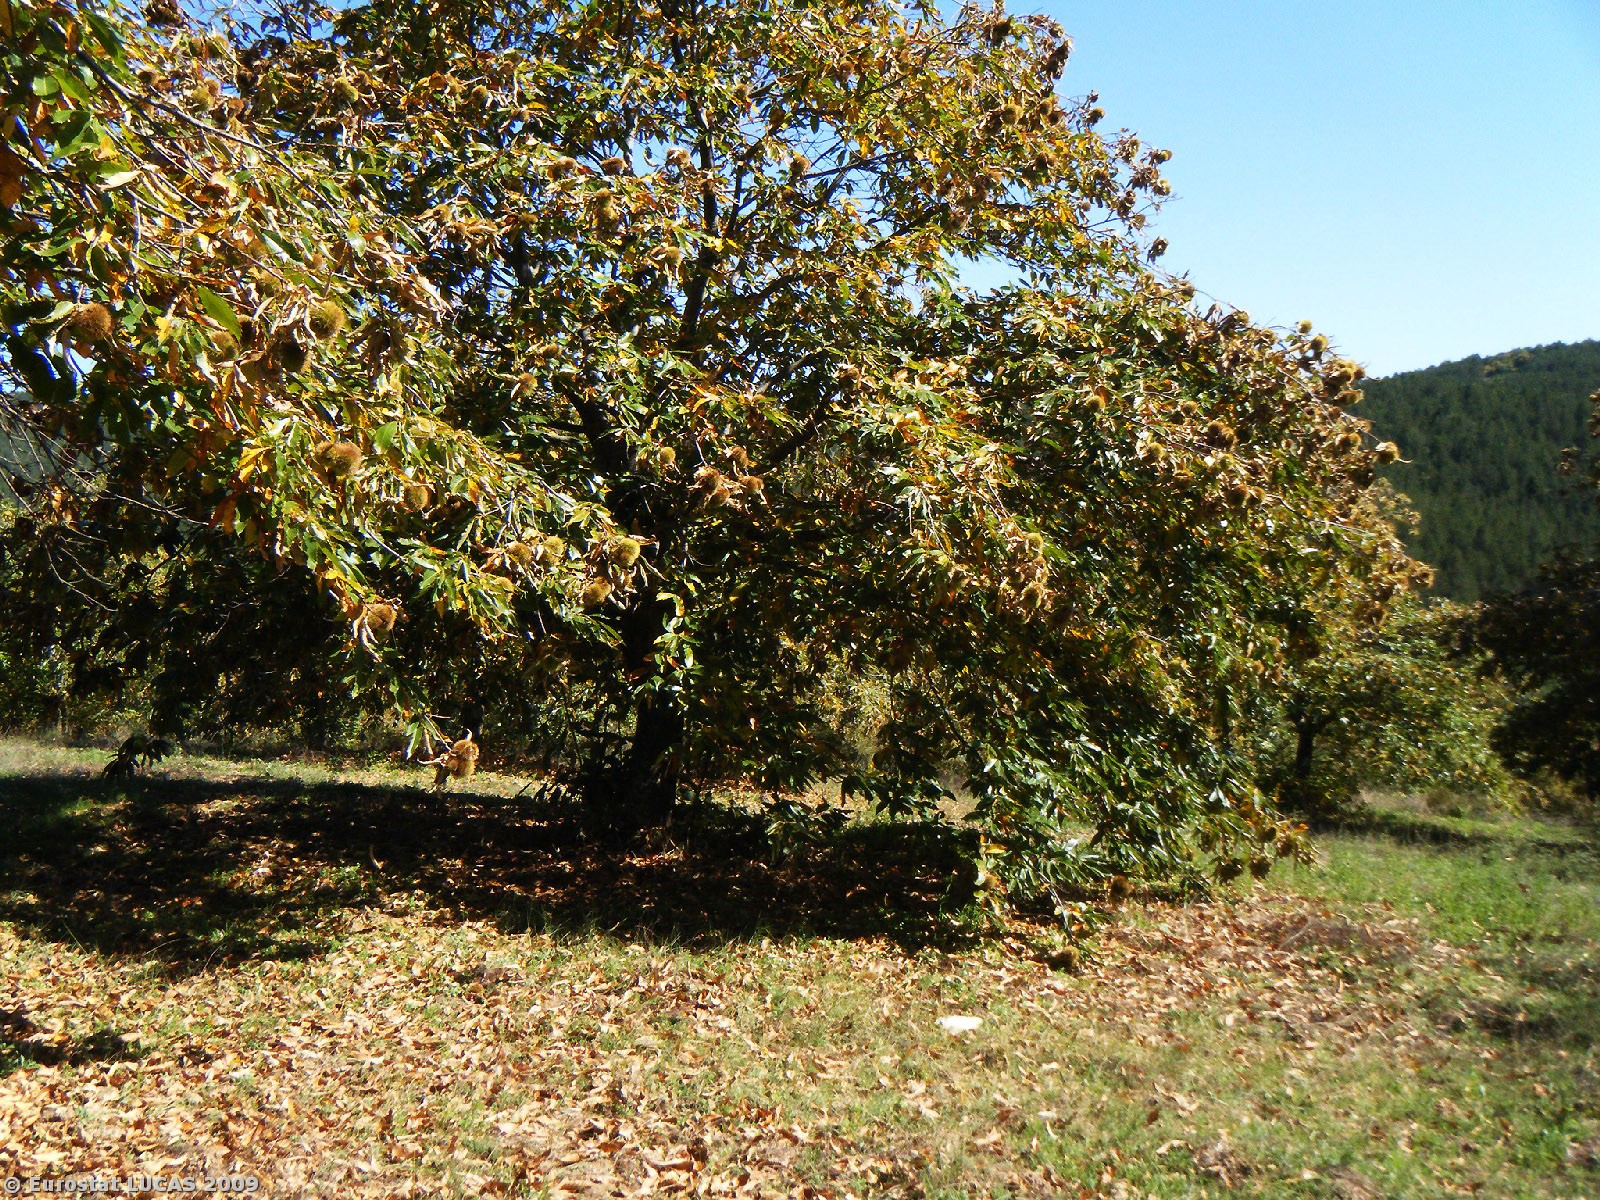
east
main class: Cropland
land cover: Nuts trees
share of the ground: 25 - 50 %
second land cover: Grassland with sparse tree/shrub cover
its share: > 75 %
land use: Agriculture (excluding fallow land and kitchen gardens)
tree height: > 5 m
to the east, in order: Nuts trees; Grassland with sparse tree/shrub cover; Abandoned hedges; Nuts trees; Grassland with sparse tree/shrub cover; Shrubland without tree cover; Nuts trees; Grassland with sparse tree/shrub cover; Shrubland without tree cover; Nuts trees; Grassland with sparse tree/shrub cover; Shrubland without tree cover; Nuts trees; Grassland with sparse tree/shrub cover; Shrubland with sparse tree cover; Tracks; Broadleaved woodland; Nuts trees; Grassland with sparse tree/shrub cover; Shruby margins; Tracks; Coniferous woodland; Shrubland without tree cover; Coniferous woodland
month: October
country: GR
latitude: 37.3405
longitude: 22.3644
